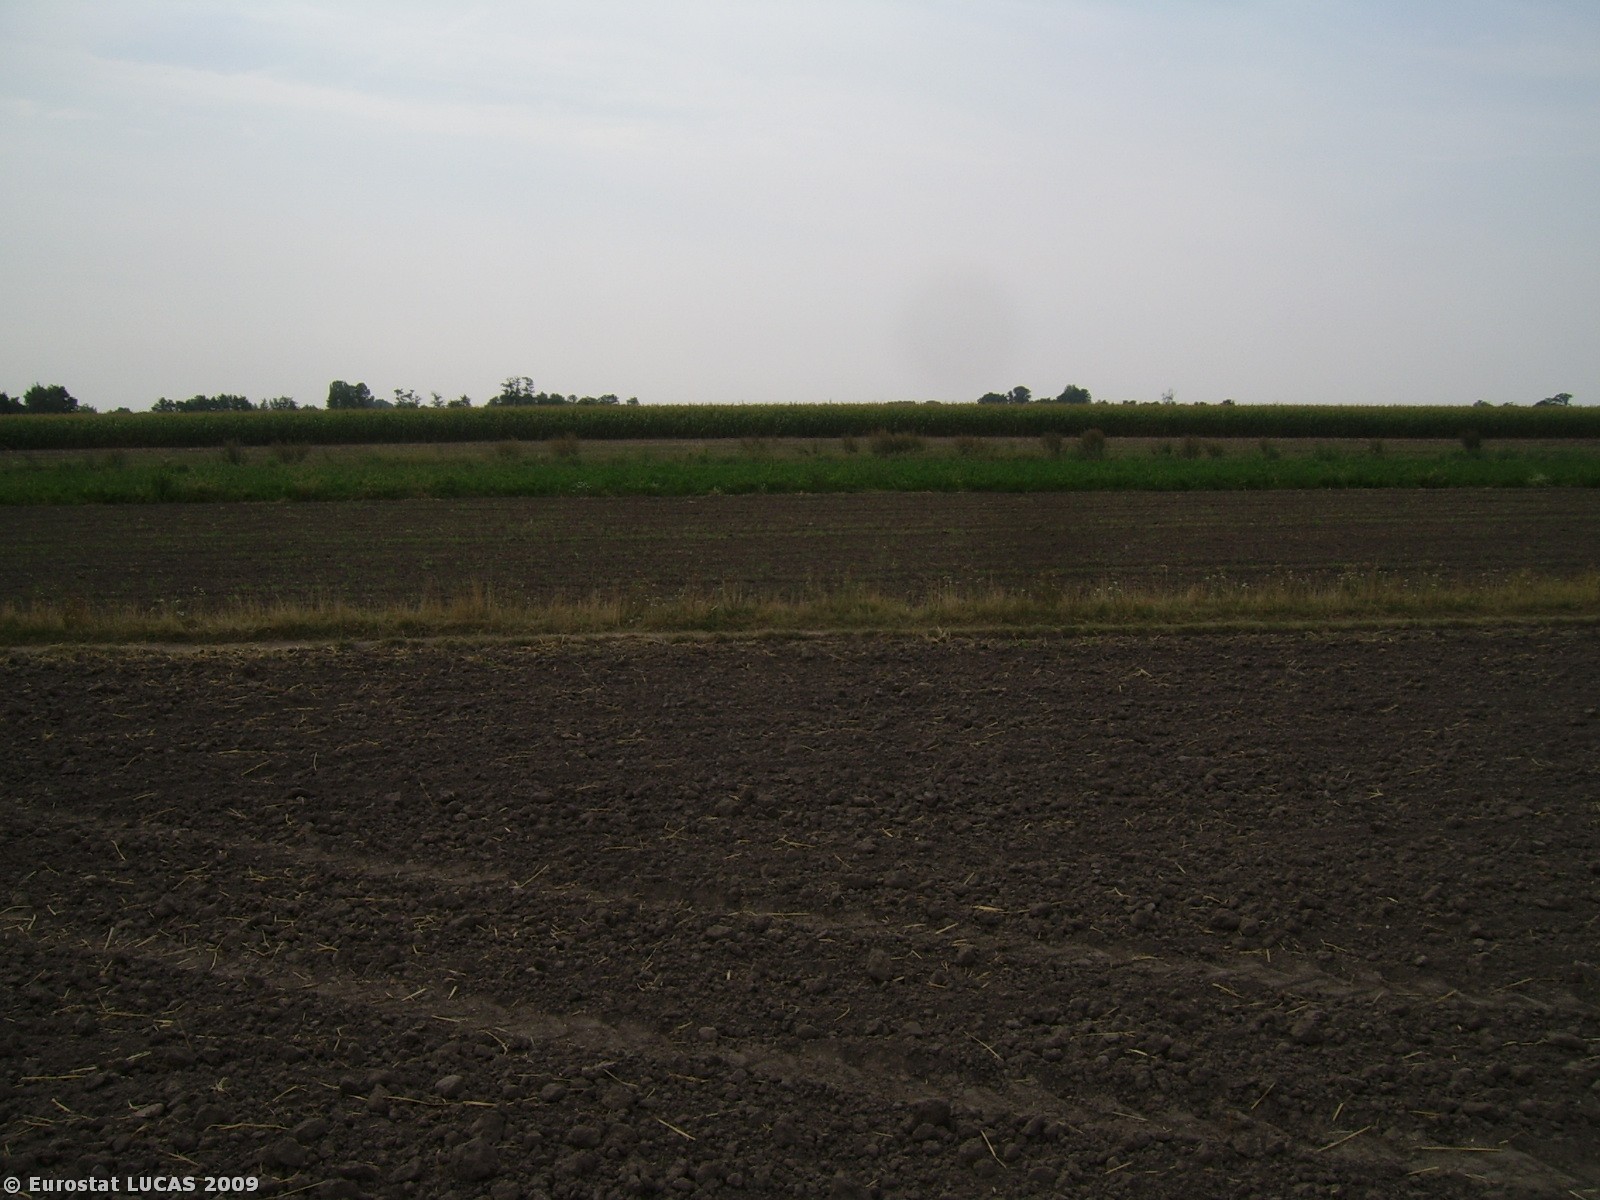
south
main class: Cropland
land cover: Mixed cereals for fodder
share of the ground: < 10 %
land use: Agriculture (excluding fallow land and kitchen gardens)
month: August
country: PL
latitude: 51.7316
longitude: 18.4604
